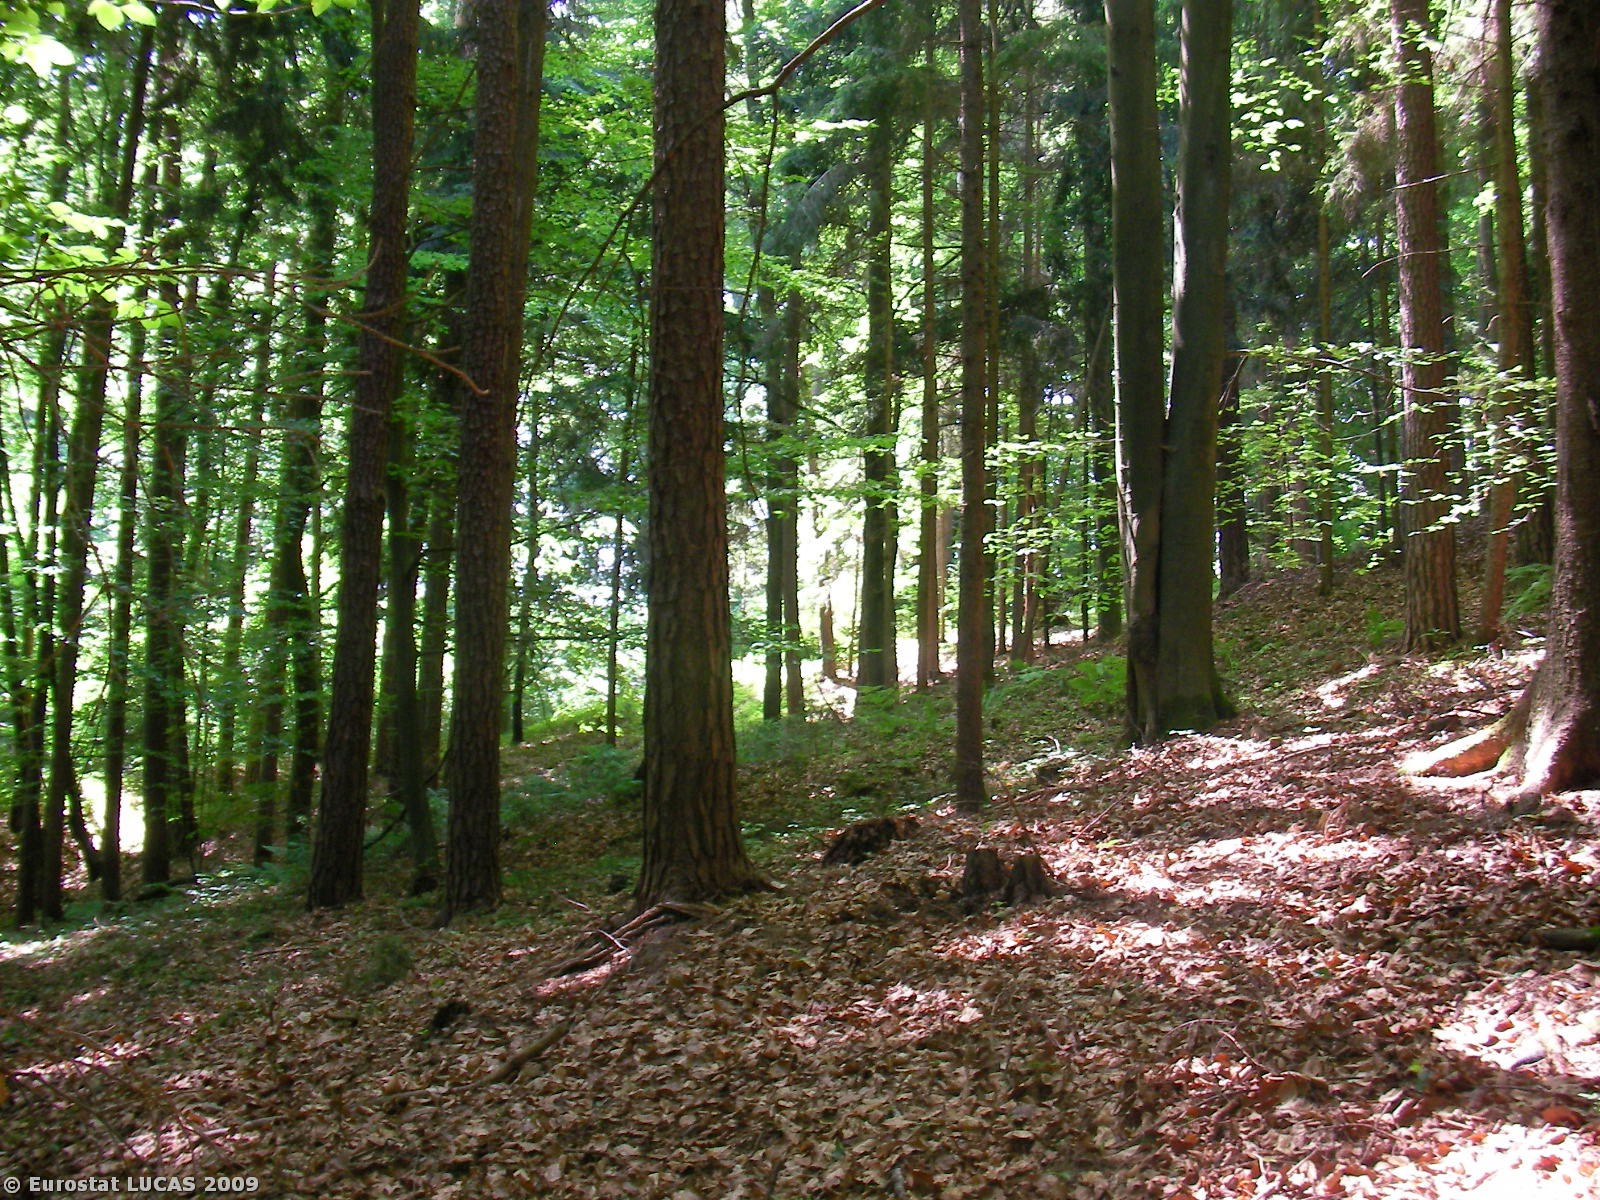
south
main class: Woodland
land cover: Mixed woodland
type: hemiboreal forest and nemoral coniferous forest and mixed broadleaved-coniferous forest
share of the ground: > 75 %
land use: Forestry
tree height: > 5 m
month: May
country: AT
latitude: 47.1621
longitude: 15.5802
